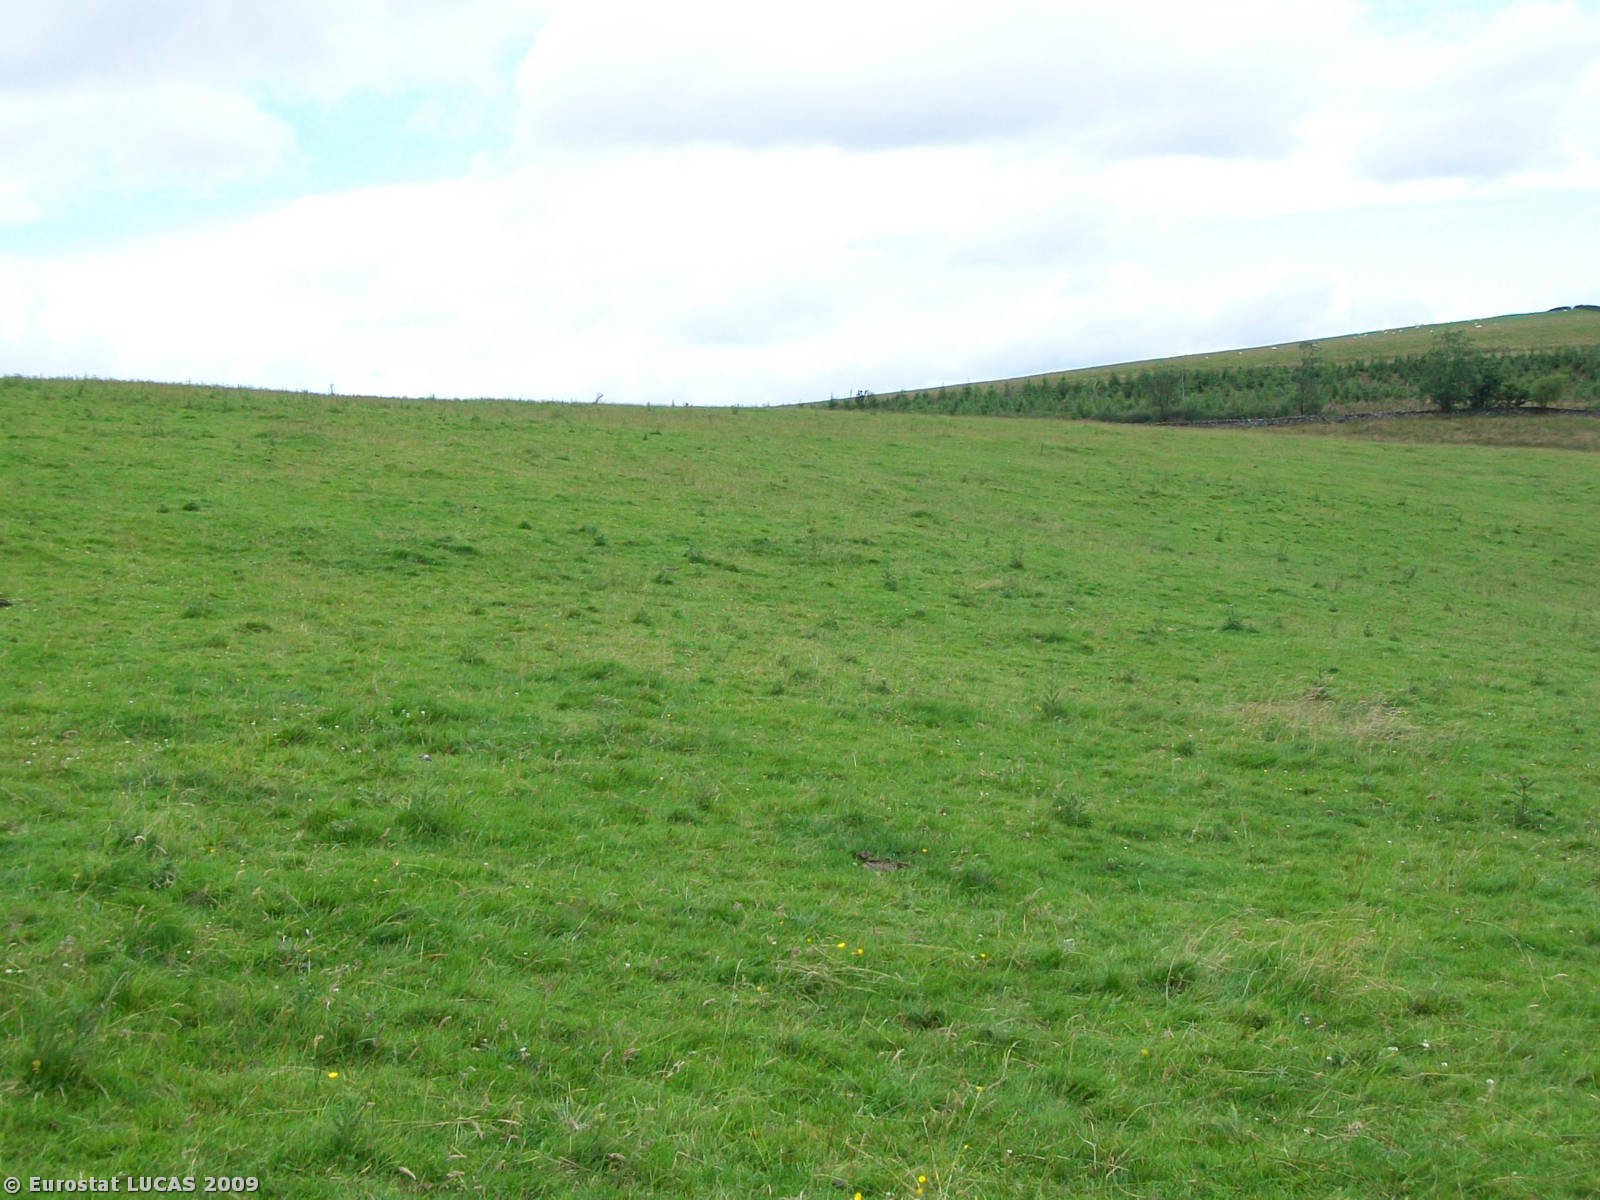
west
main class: Grassland
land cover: Grassland without tree/shrub cover
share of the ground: > 75 %
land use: Agriculture (excluding fallow land and kitchen gardens)
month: July
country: GB
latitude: 55.1619
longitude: -3.3085
